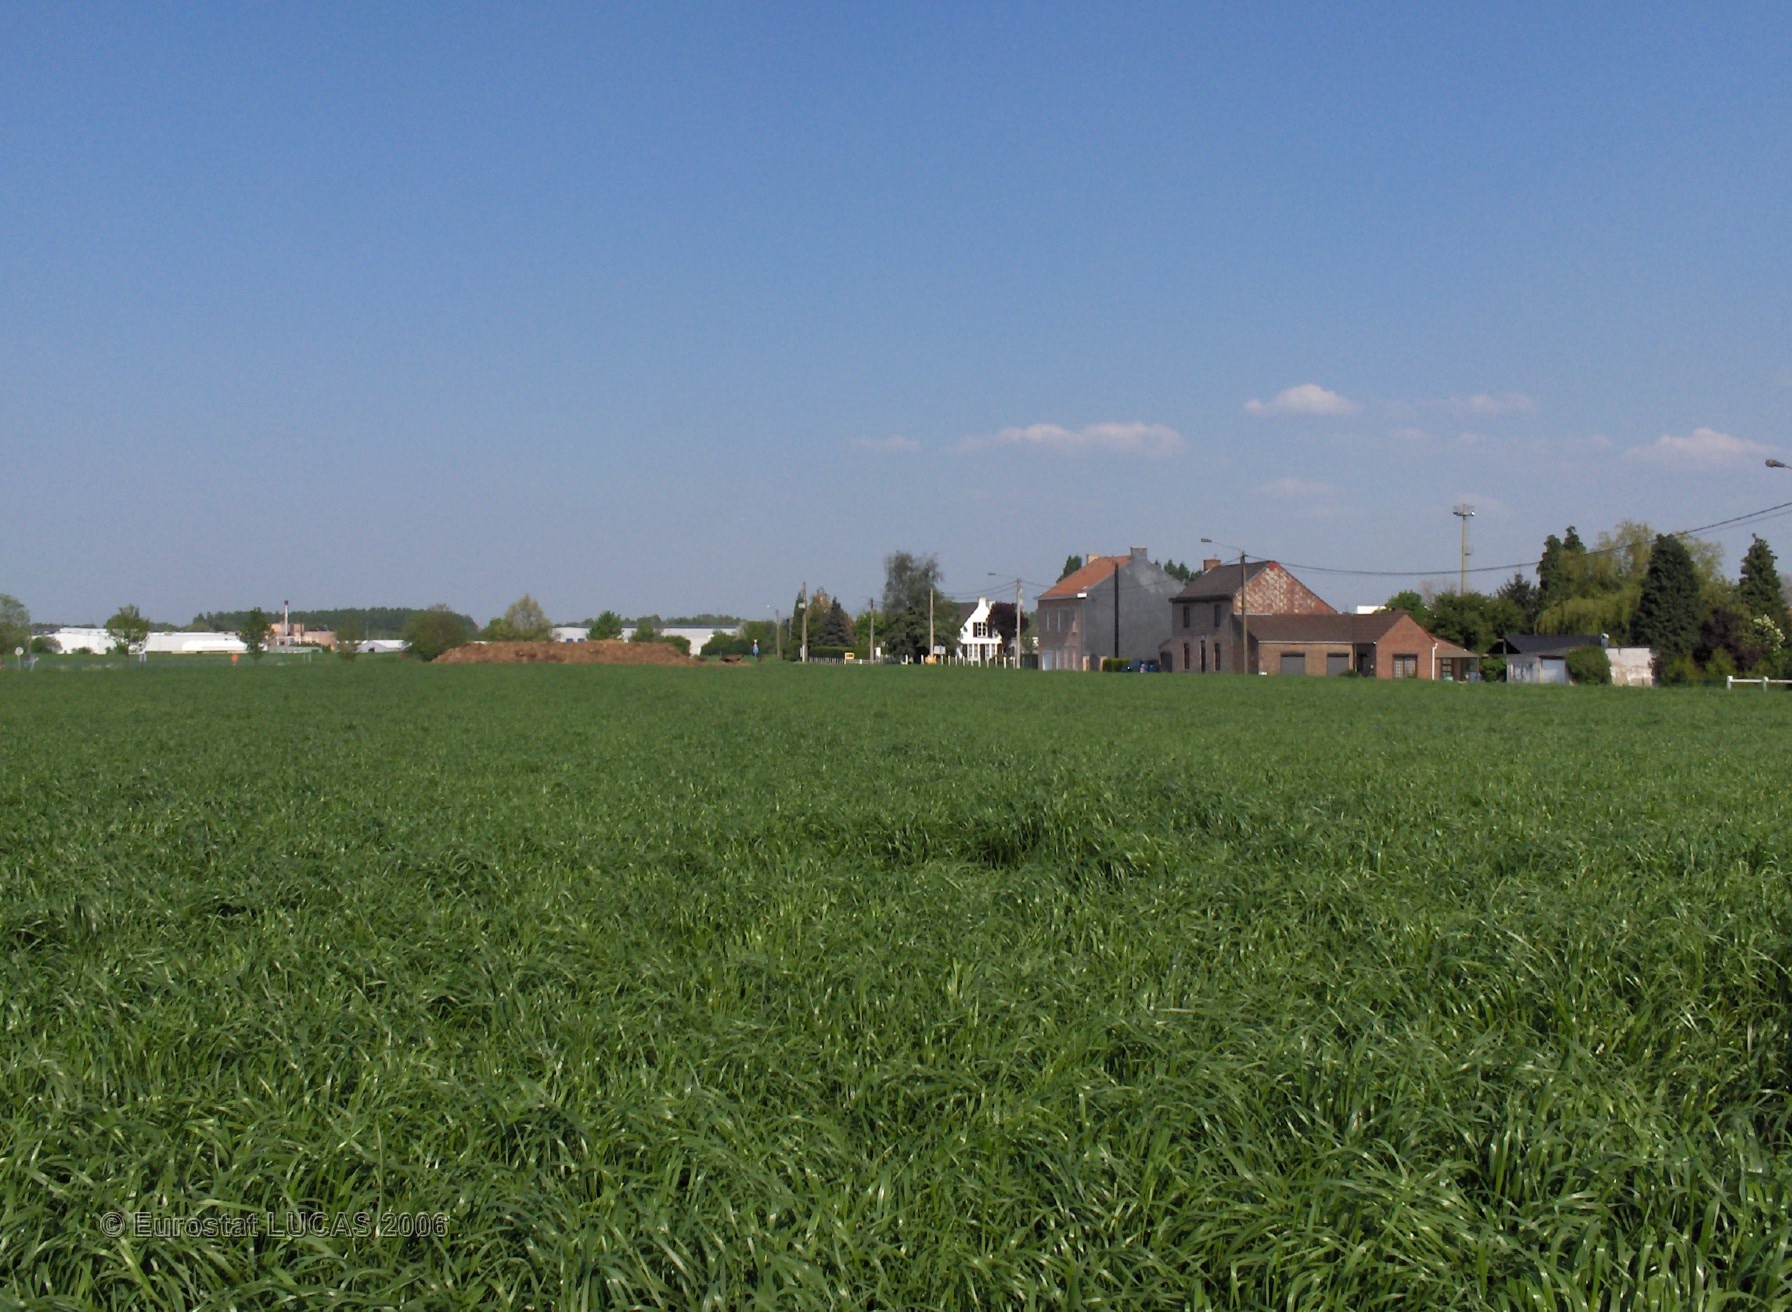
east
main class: Grassland
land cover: Grassland without tree/shrub cover
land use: Agriculture (excluding fallow land and kitchen gardens)
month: May
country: BE
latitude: 50.4655
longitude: 4.4874
